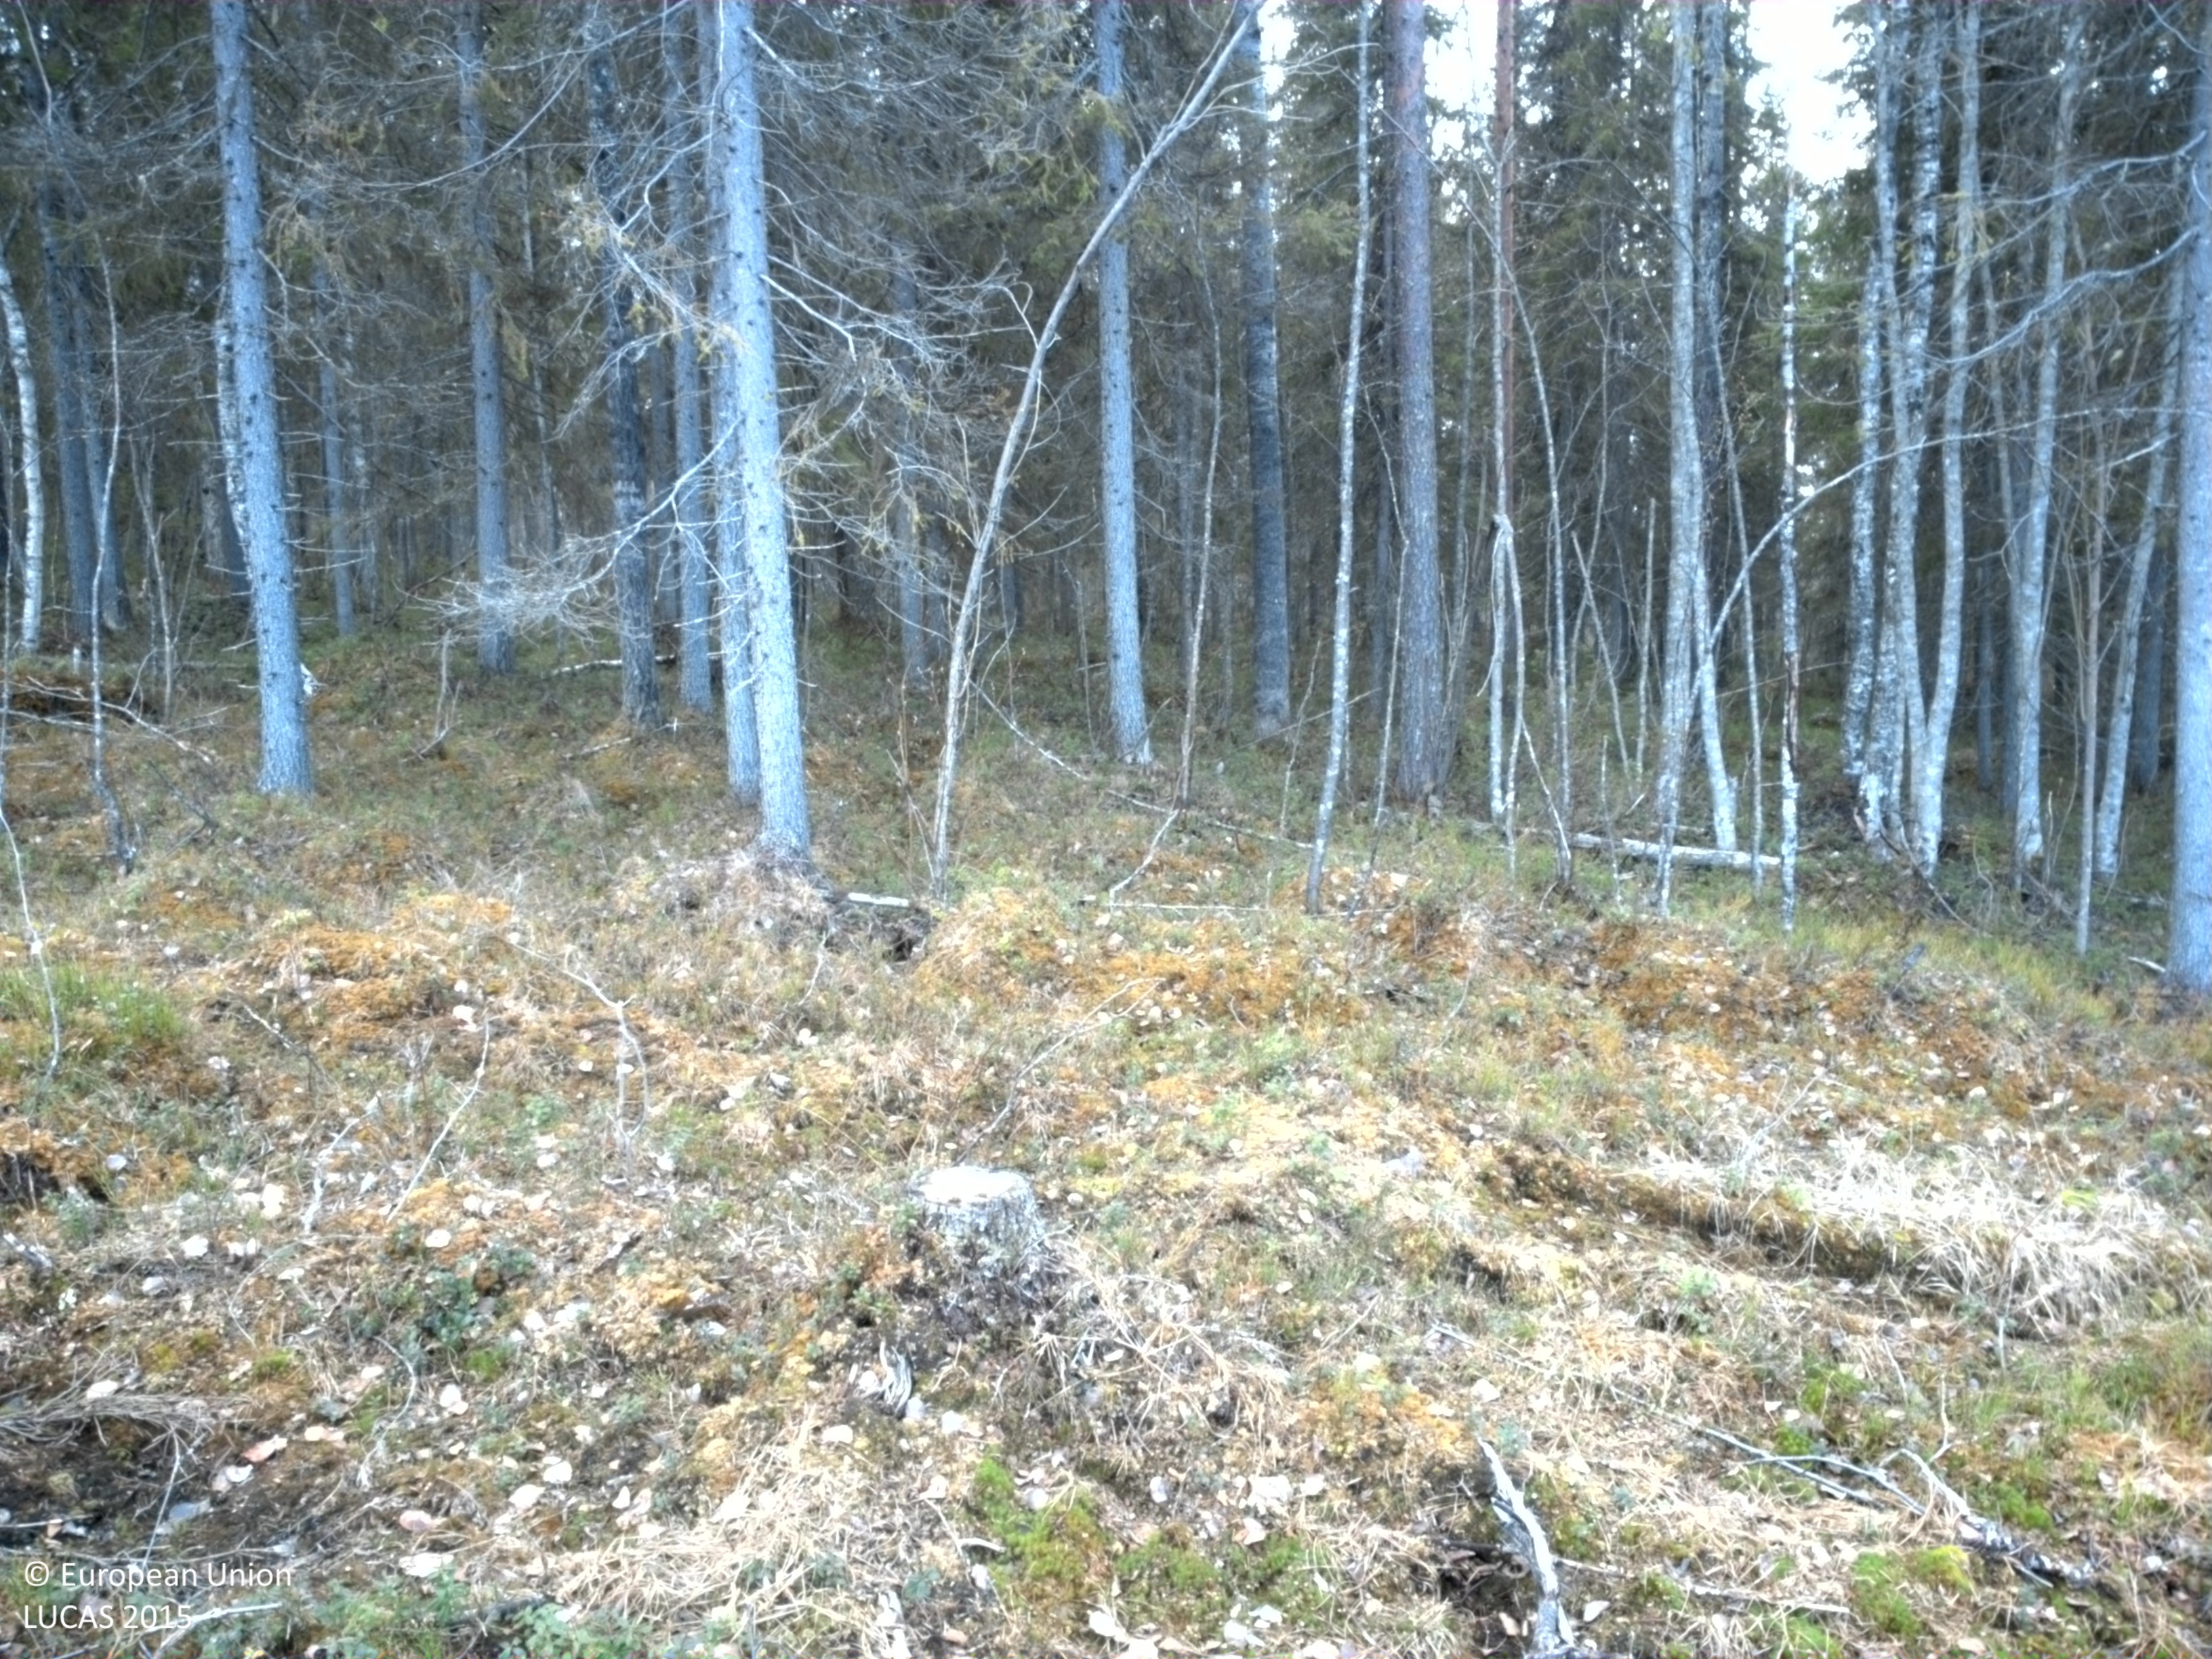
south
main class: Shrubland
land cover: Shrubland with sparse tree cover
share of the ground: 10 - 25 %
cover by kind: shrubs 20 %, unconsolidated bare surface 15 %, broadleaved forest trees 5 %, lichens and mosses 5 %
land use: Forestry
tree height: < 5 m
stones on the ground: 10 - 25 %
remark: Clear cut
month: May
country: SE
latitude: 66.3358
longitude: 23.5395
